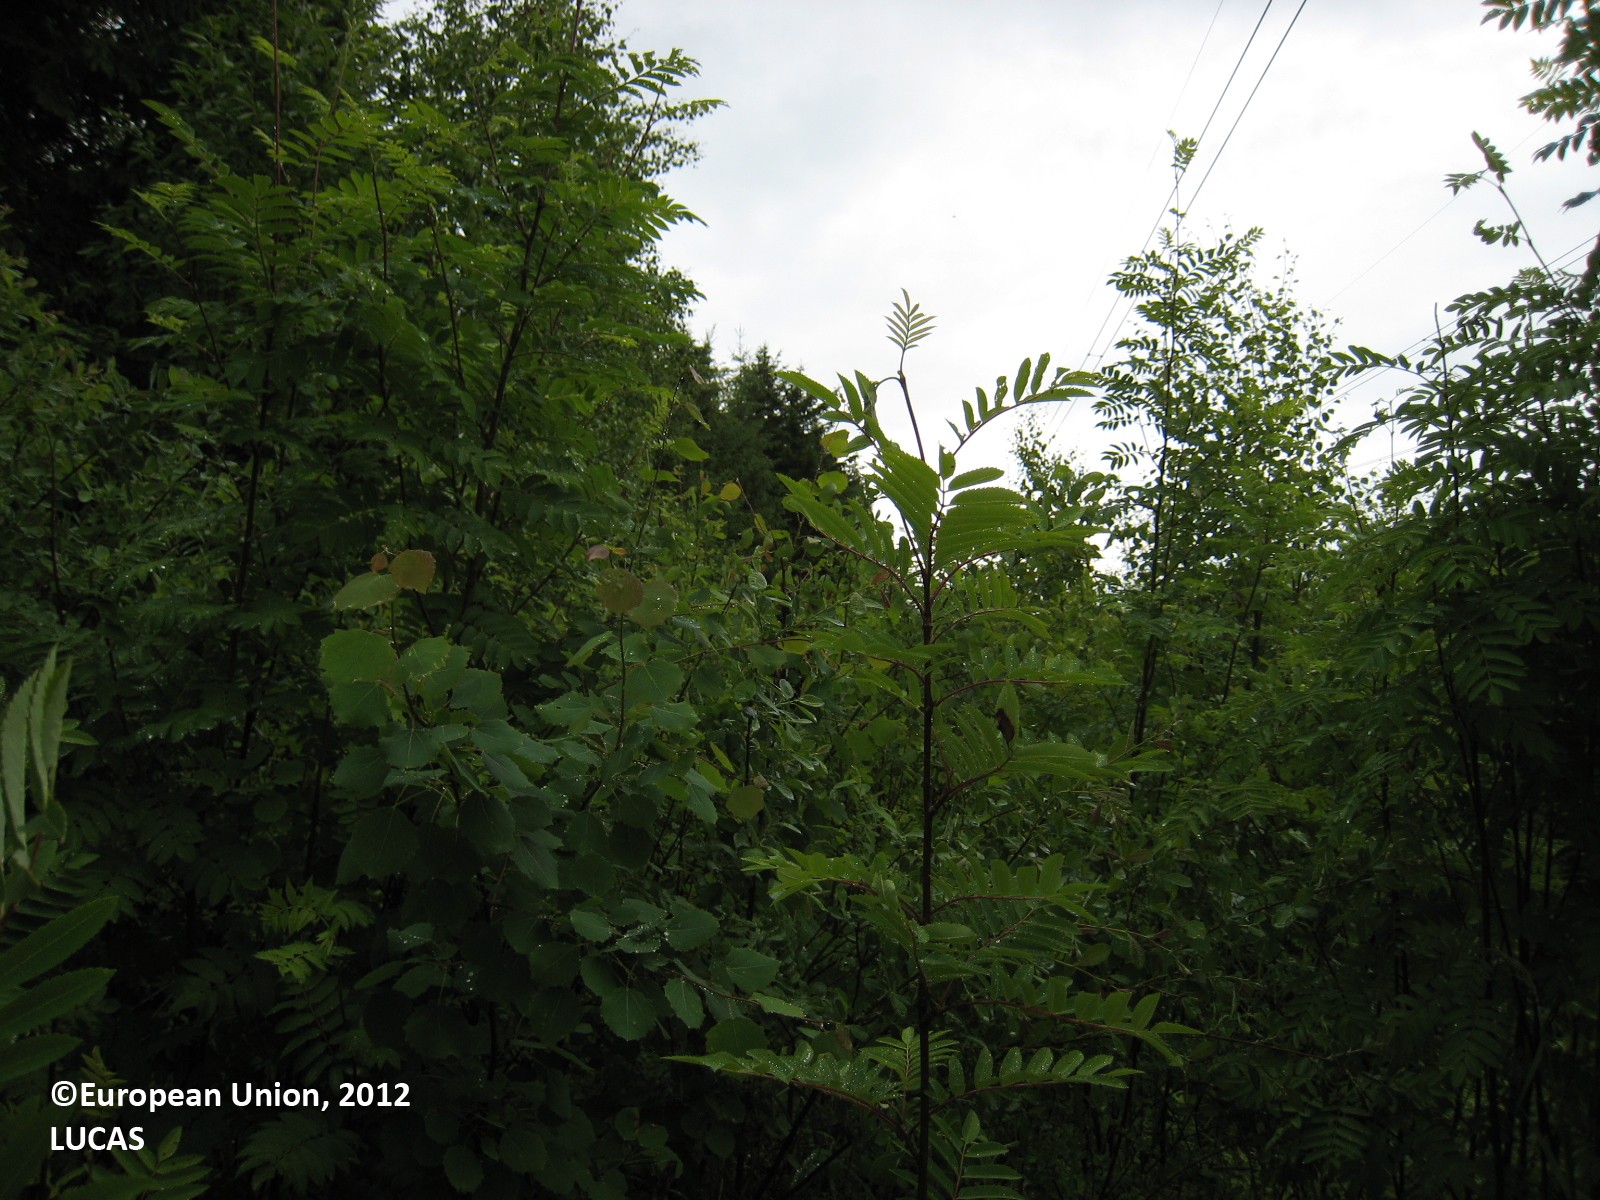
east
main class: Woodland
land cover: Broadleaved woodland
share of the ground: > 75 %
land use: Energy production
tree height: < 5 m
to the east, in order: Broadleaved woodland; Spruce dominated mixed woodland; Ditches and canals; Spruce dominated mixed woodland; Ditches and canals; Spruce dominated mixed woodland; Ditches and canals; Spruce dominated mixed woodland; Ditches and canals; Grassland without tree/shrub cover; Tracks; Grass margins; Pine dominated coniferous woodland; Other mixed woodland; Ditches and canals; Shrubland with sparse tree cover; Ditches and canals
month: June
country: FI
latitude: 62.3004
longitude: 26.3533
